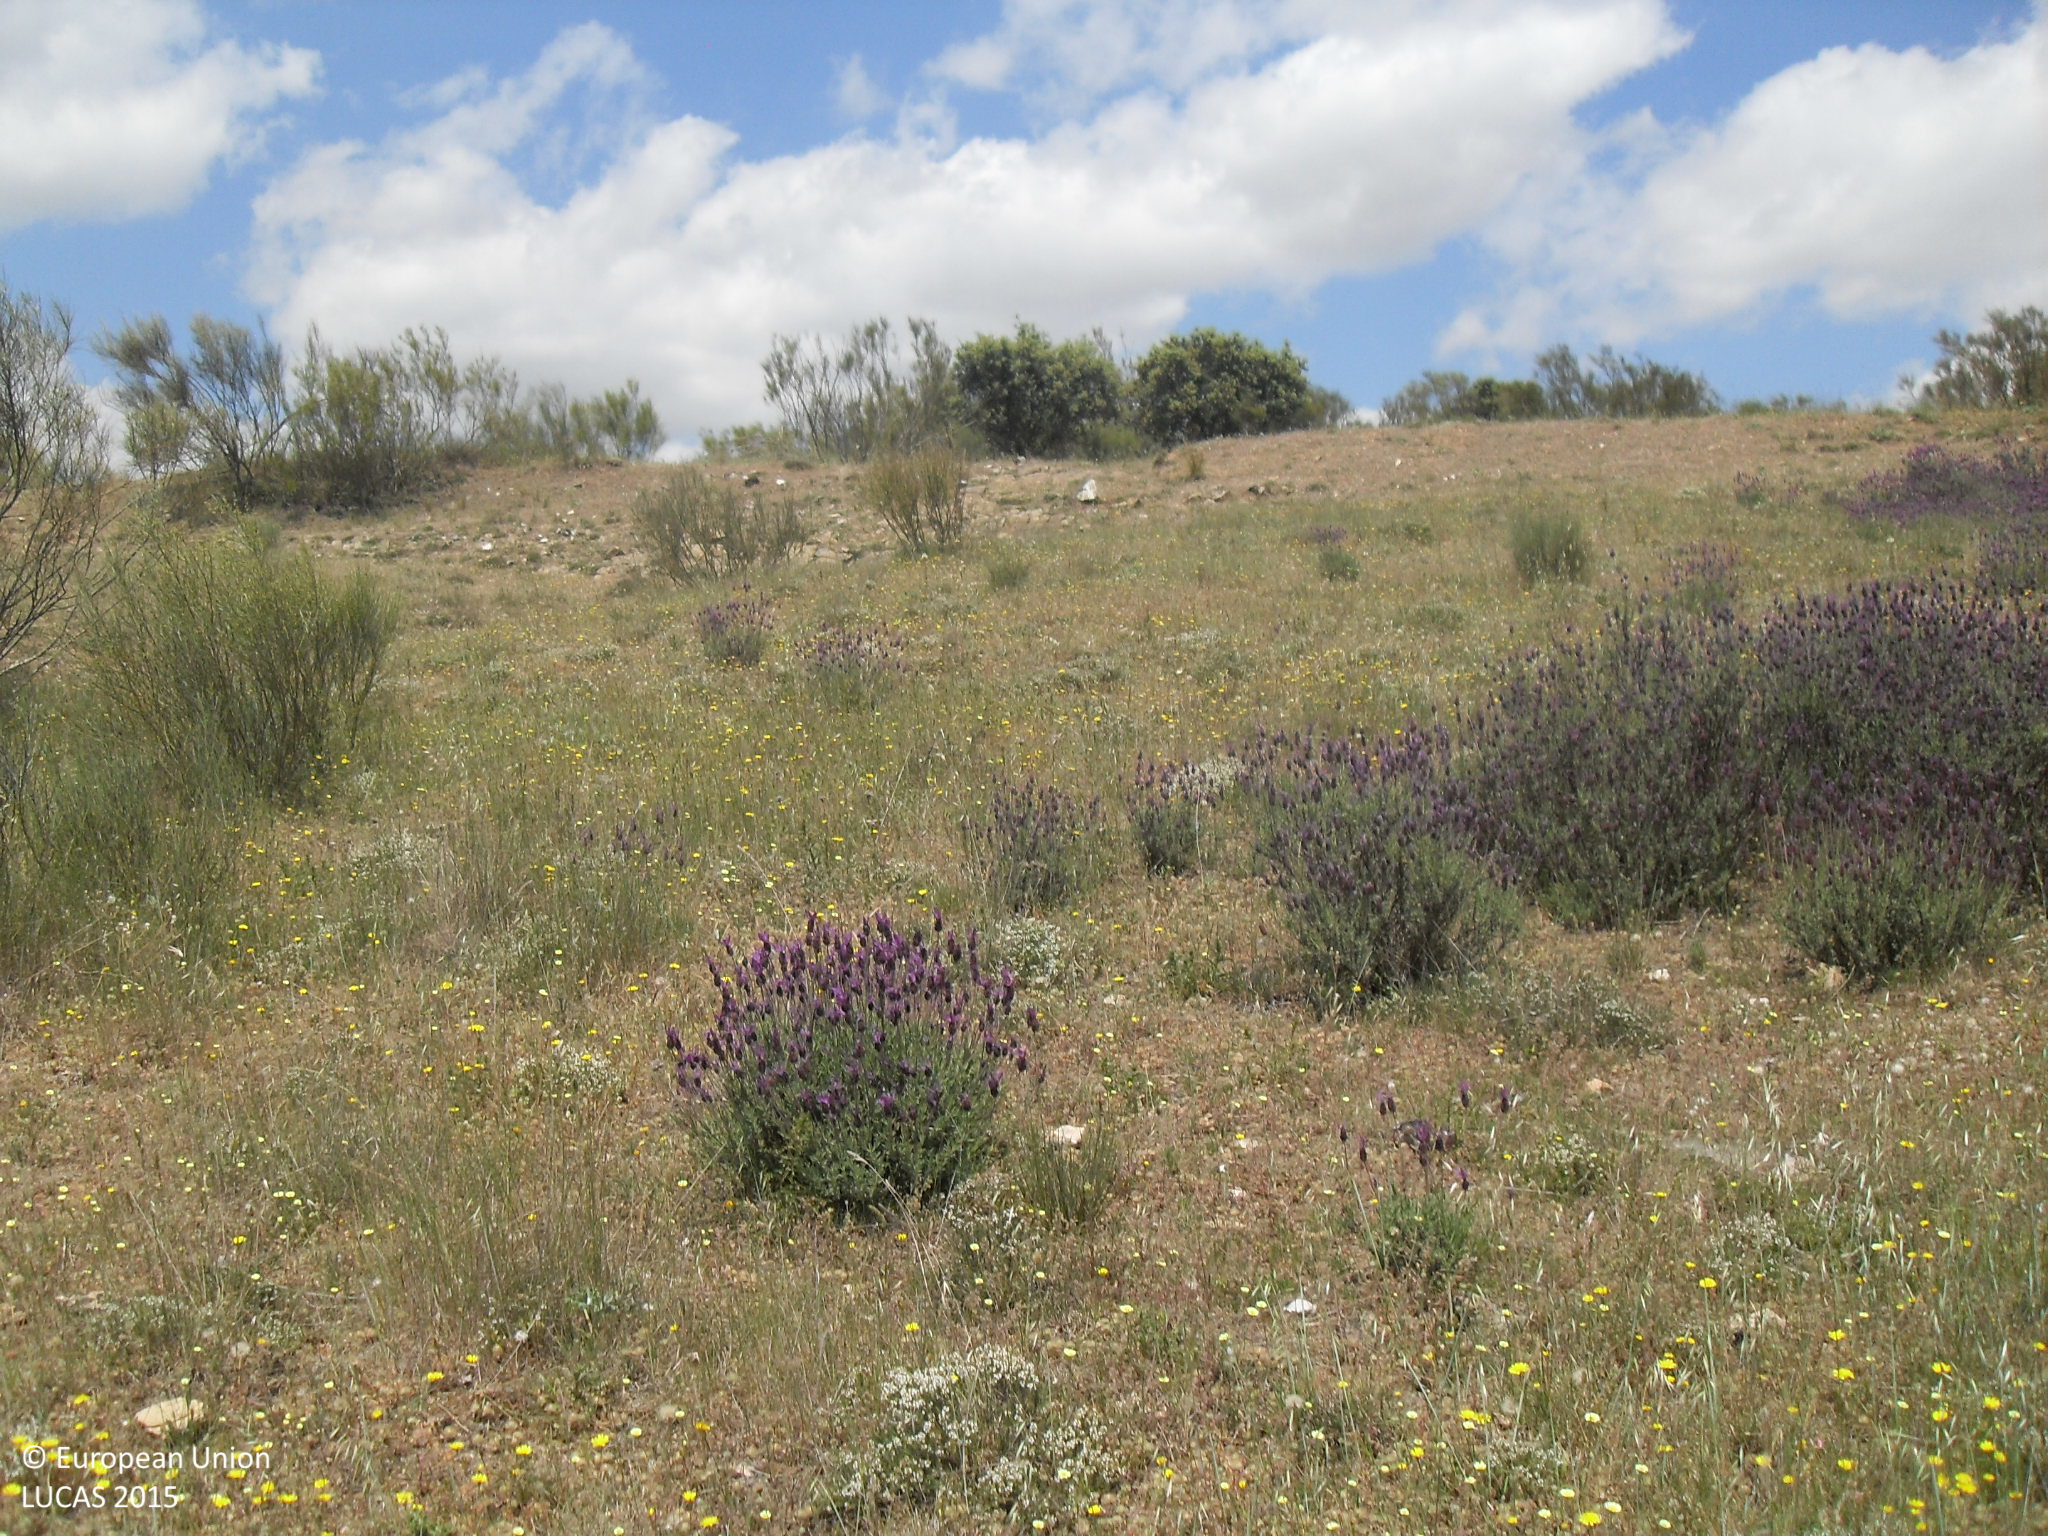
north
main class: Shrubland
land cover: Shrubland without tree cover
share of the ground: 10 - 25 %
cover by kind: herbaceous plants 80 %, shrubs 20 %
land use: Agriculture (excluding fallow land and kitchen gardens)
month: May
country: ES
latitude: 40.7531
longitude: -5.6251
